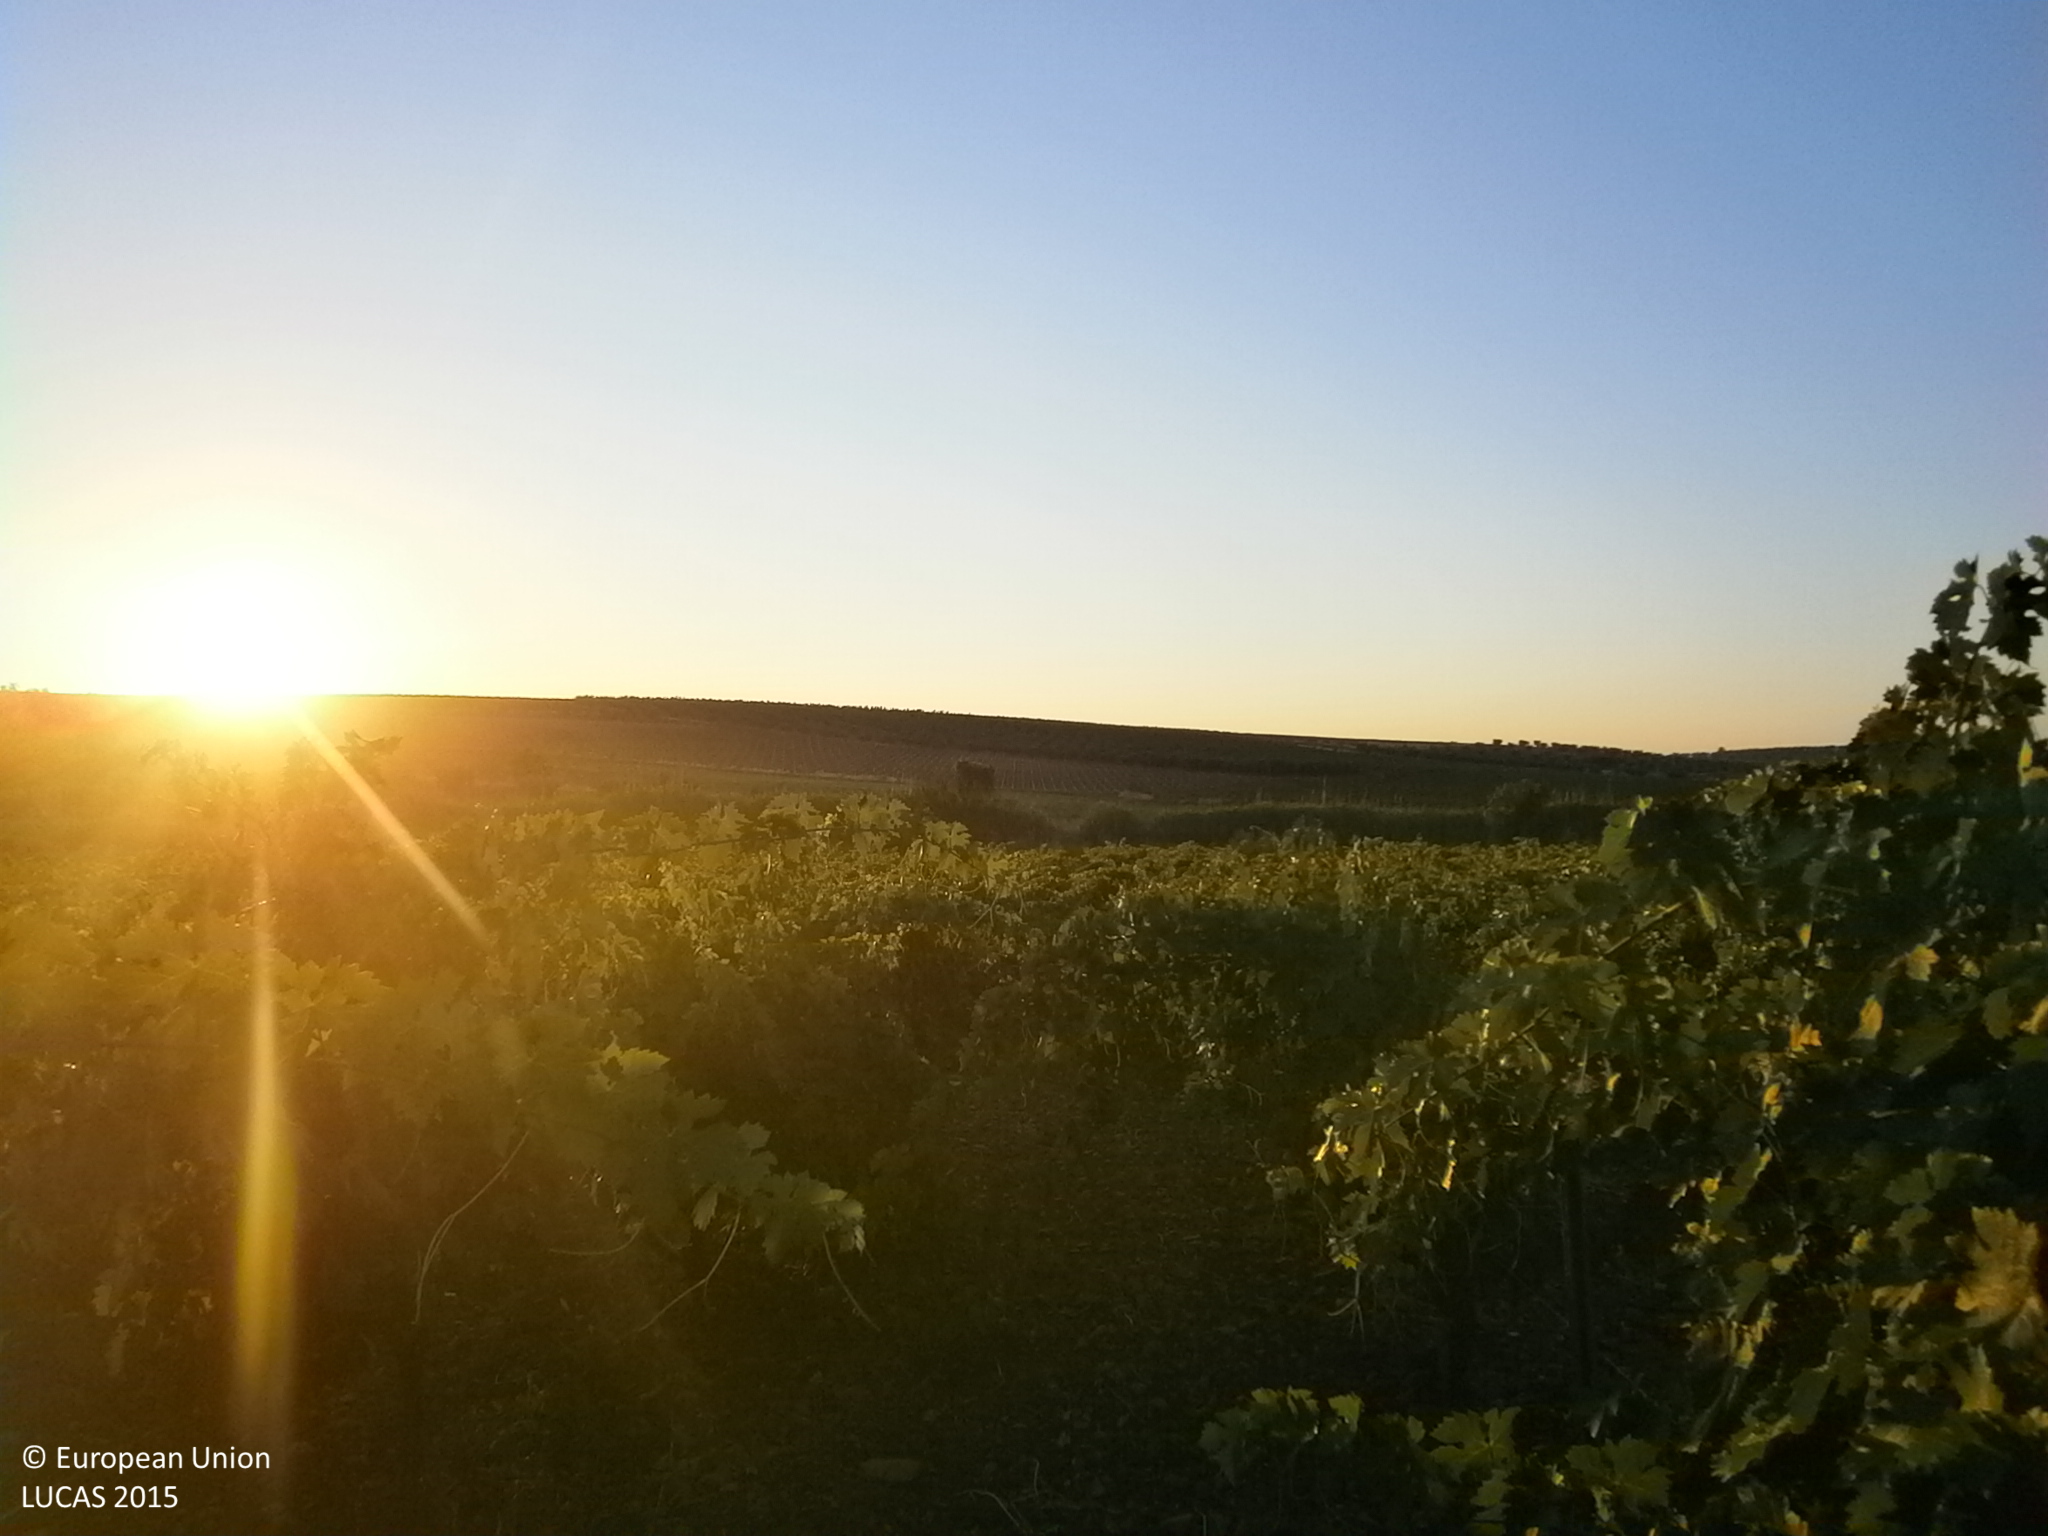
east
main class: Cropland
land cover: Vineyards
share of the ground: 25 - 50 %
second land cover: Other bare soil
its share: > 75 %
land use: Agriculture (excluding fallow land and kitchen gardens)
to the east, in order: Vineyards; Other bare soil; Shrubland with sparse tree cover; Rivers and streams; Shrubland with sparse tree cover; Vineyards; Tracks; Olive groves
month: June
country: ES
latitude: 38.6508
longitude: -6.6394
